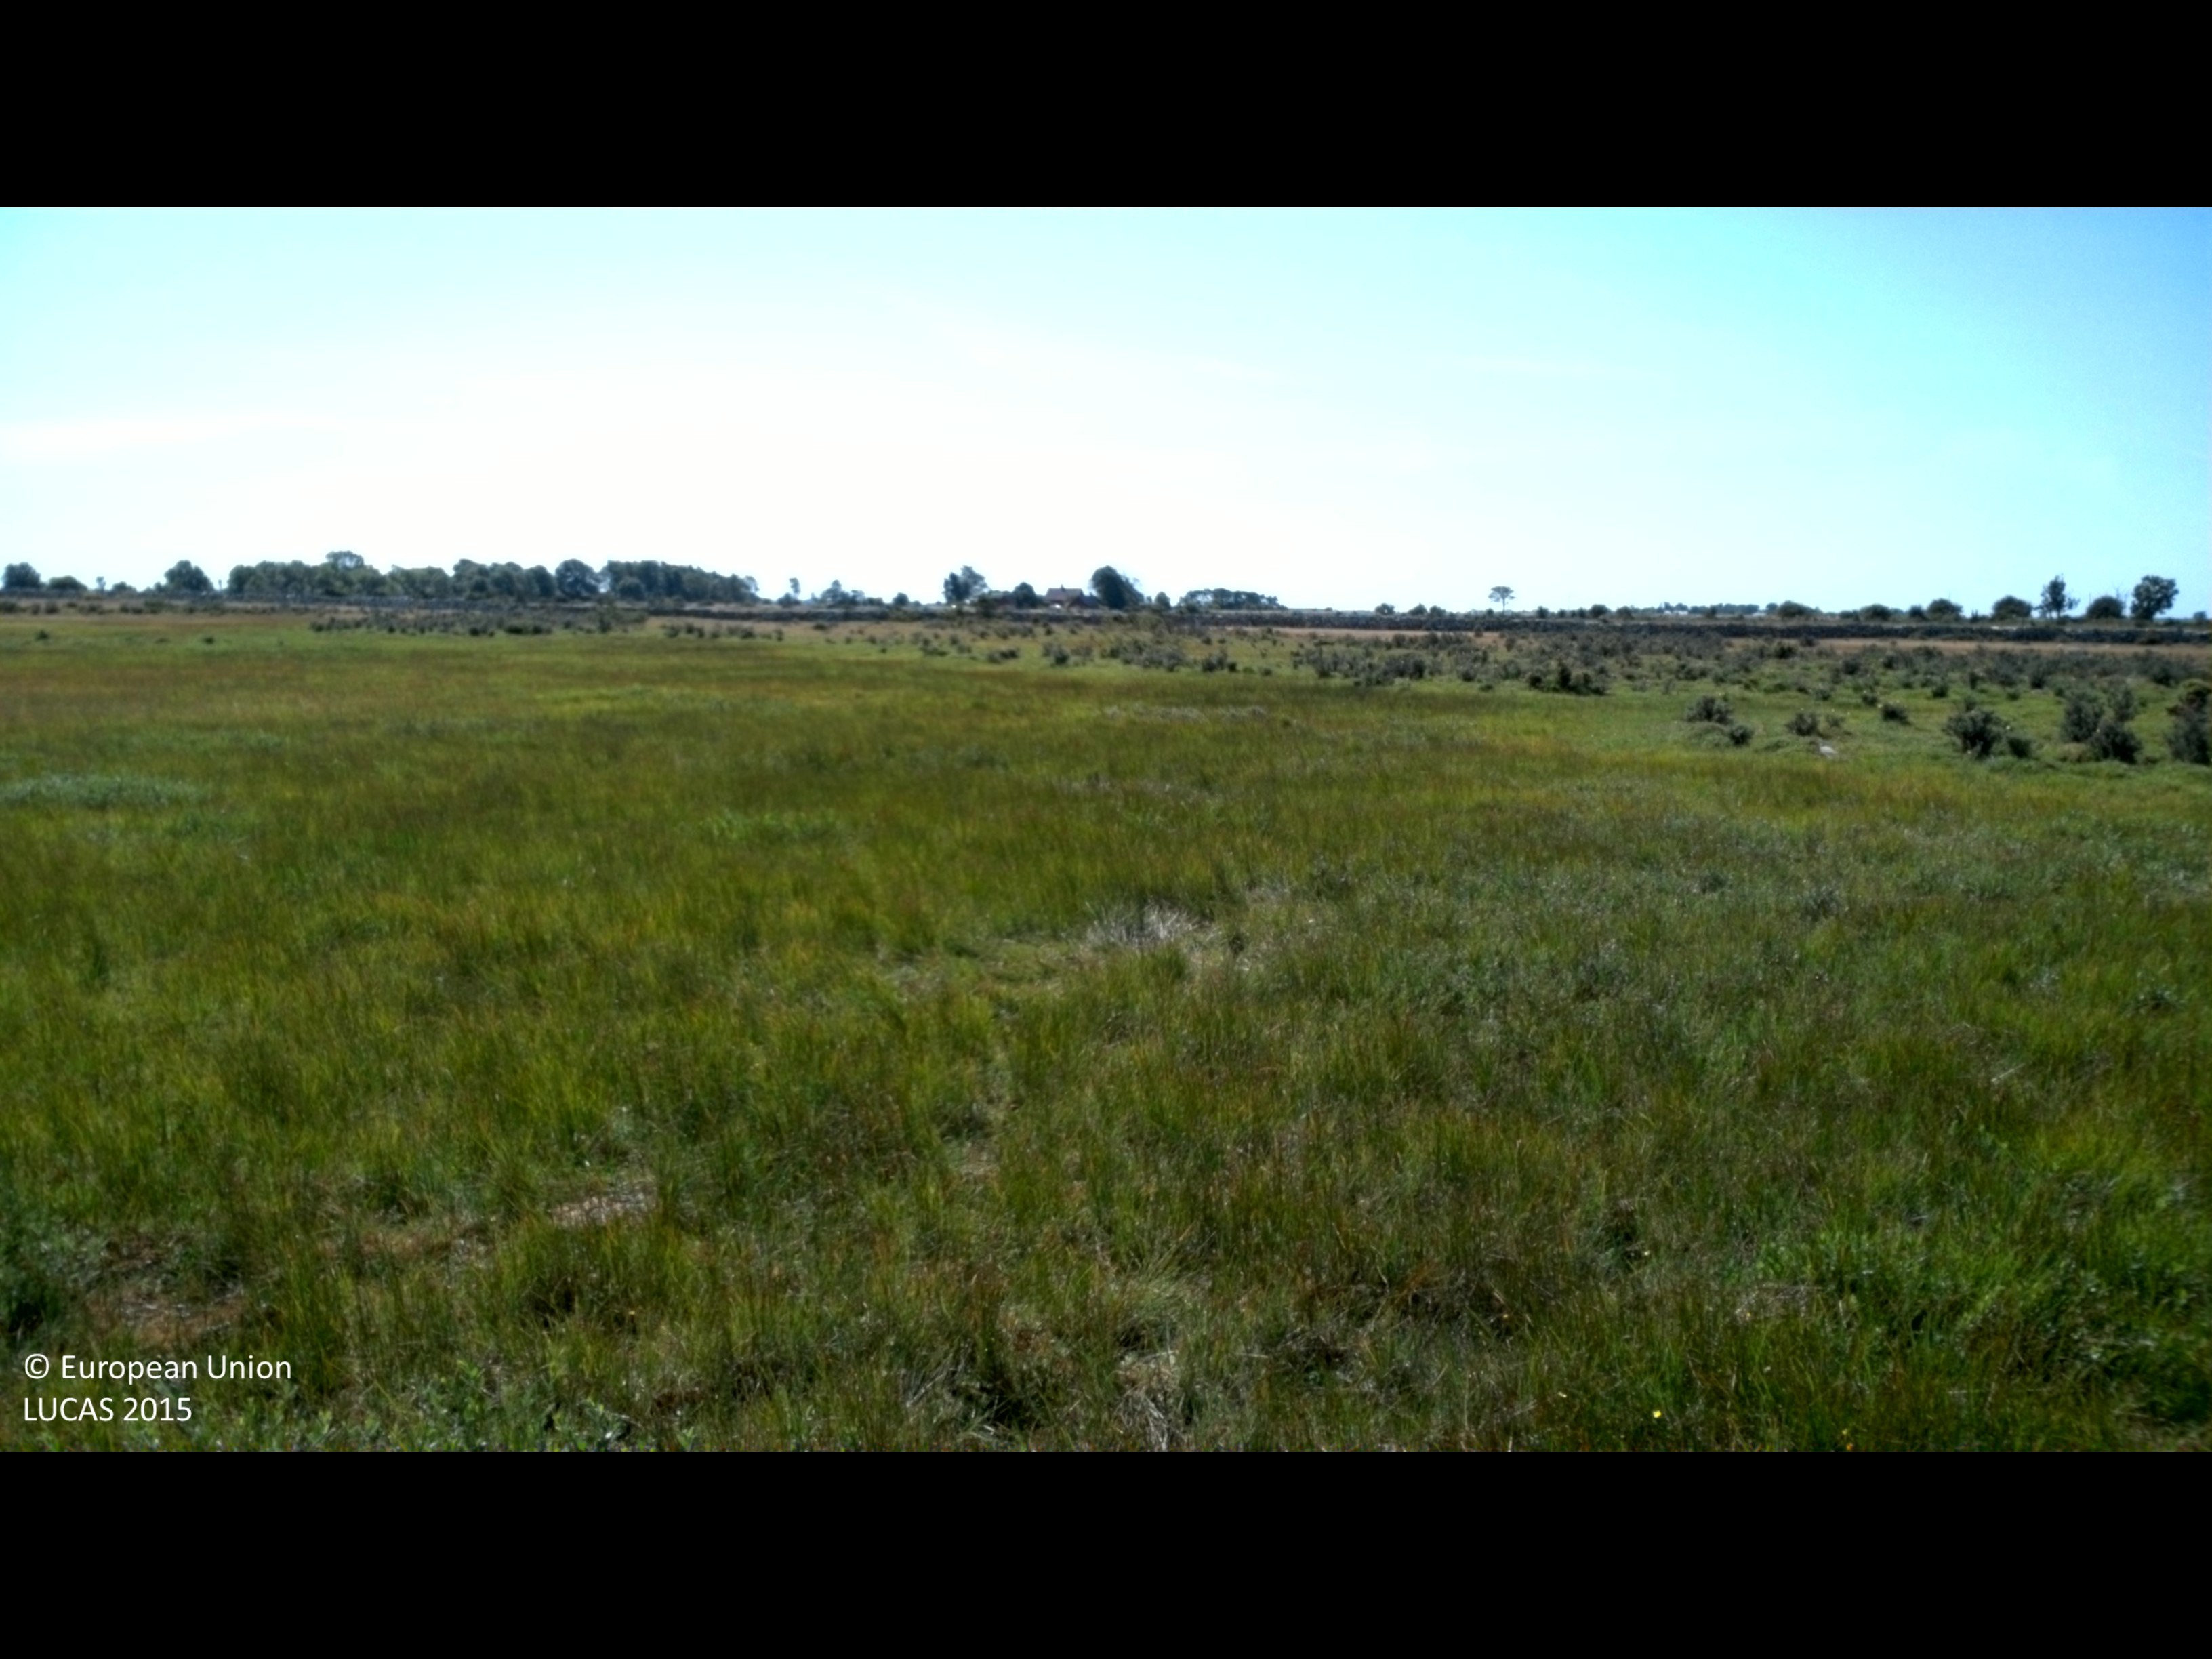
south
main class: Grassland
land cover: Grassland without tree/shrub cover
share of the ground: > 75 %
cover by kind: herbaceous plants 100 %
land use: Agriculture (excluding fallow land and kitchen gardens)
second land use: Amenities, museums, leisure
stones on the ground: < 10 %
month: July
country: SE
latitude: 56.2946
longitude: 16.4816
